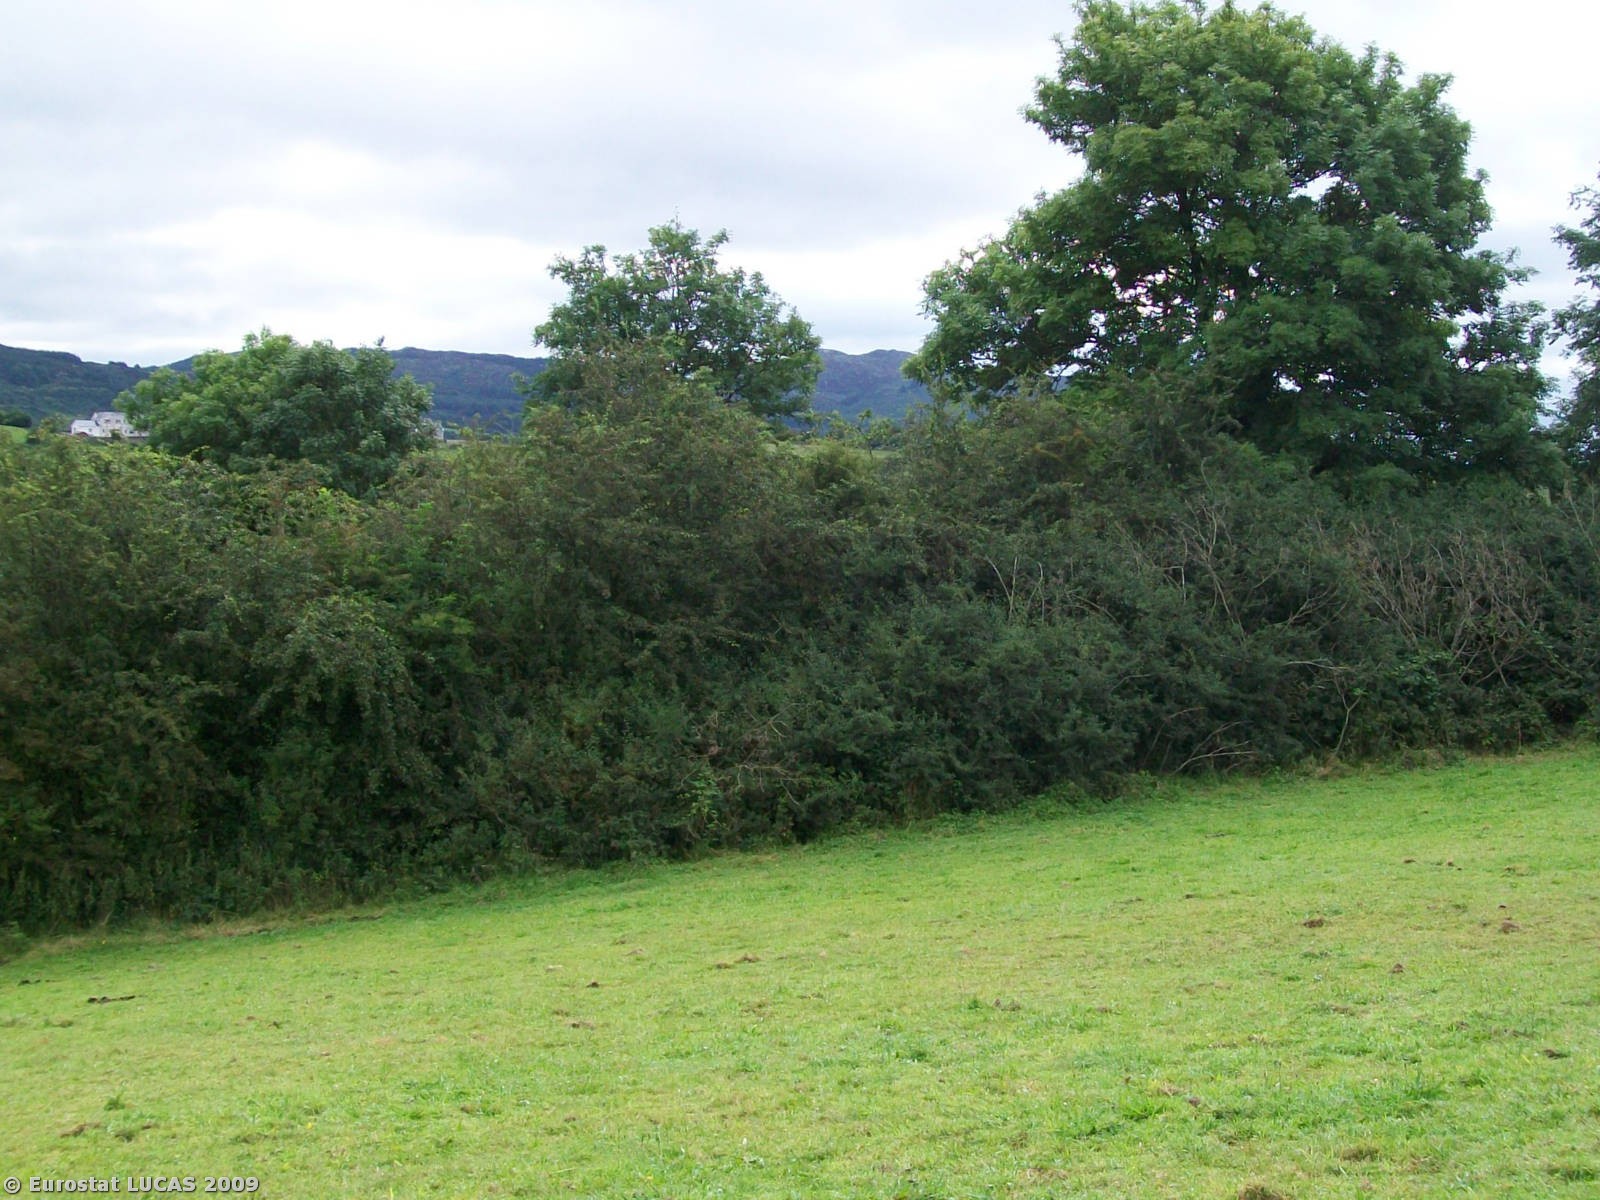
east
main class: Grassland
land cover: Grassland without tree/shrub cover
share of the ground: > 75 %
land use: Agriculture (excluding fallow land and kitchen gardens)
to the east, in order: Grassland without tree/shrub cover; Broadleaved woodland; Grassland without tree/shrub cover; Broadleaved woodland; Fences; Grassland without tree/shrub cover; Fences; Managed hedges; Grass margins; Paved roads, cycling and walking lanes; Grass margins; Managed hedges; Grassland without tree/shrub cover
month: August
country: GB
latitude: 54.0923
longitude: -6.5320
